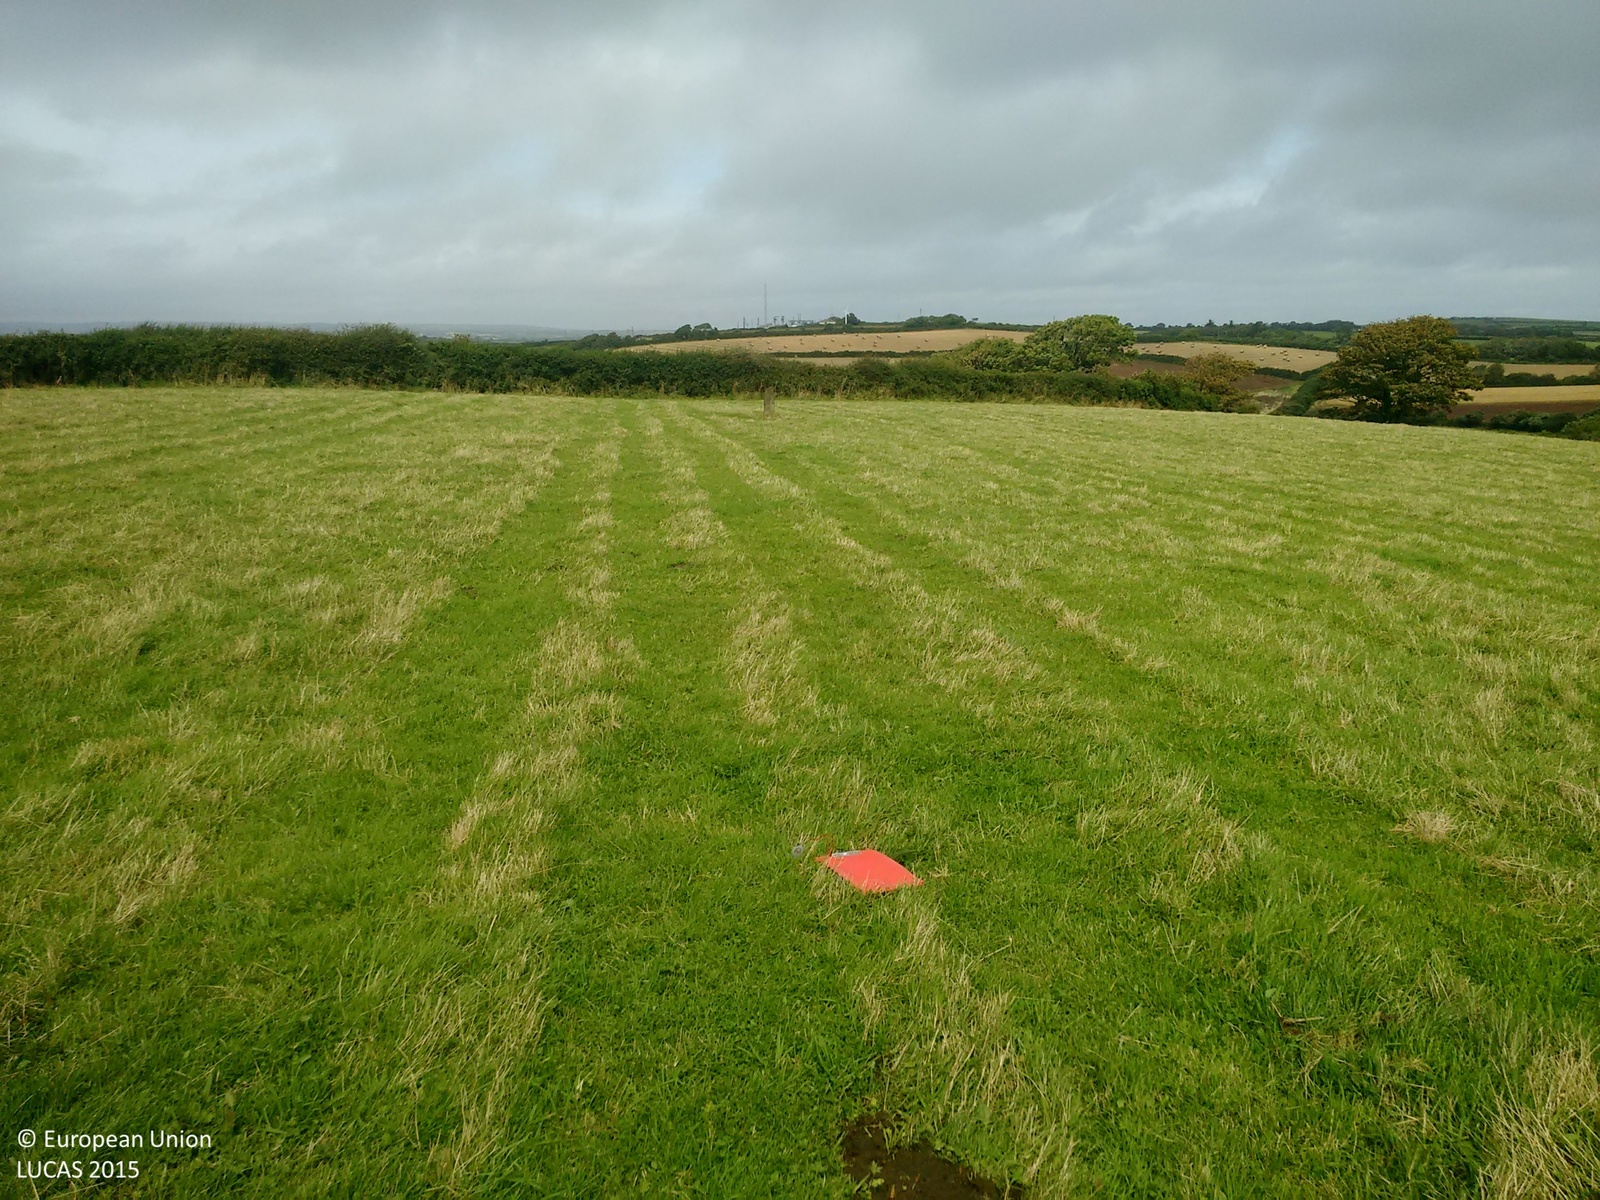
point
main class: Grassland
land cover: Grassland without tree/shrub cover
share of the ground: > 75 %
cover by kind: herbaceous plants 100 %
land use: Agriculture (excluding fallow land and kitchen gardens)
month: August
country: GB
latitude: 50.0452
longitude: -5.1298
